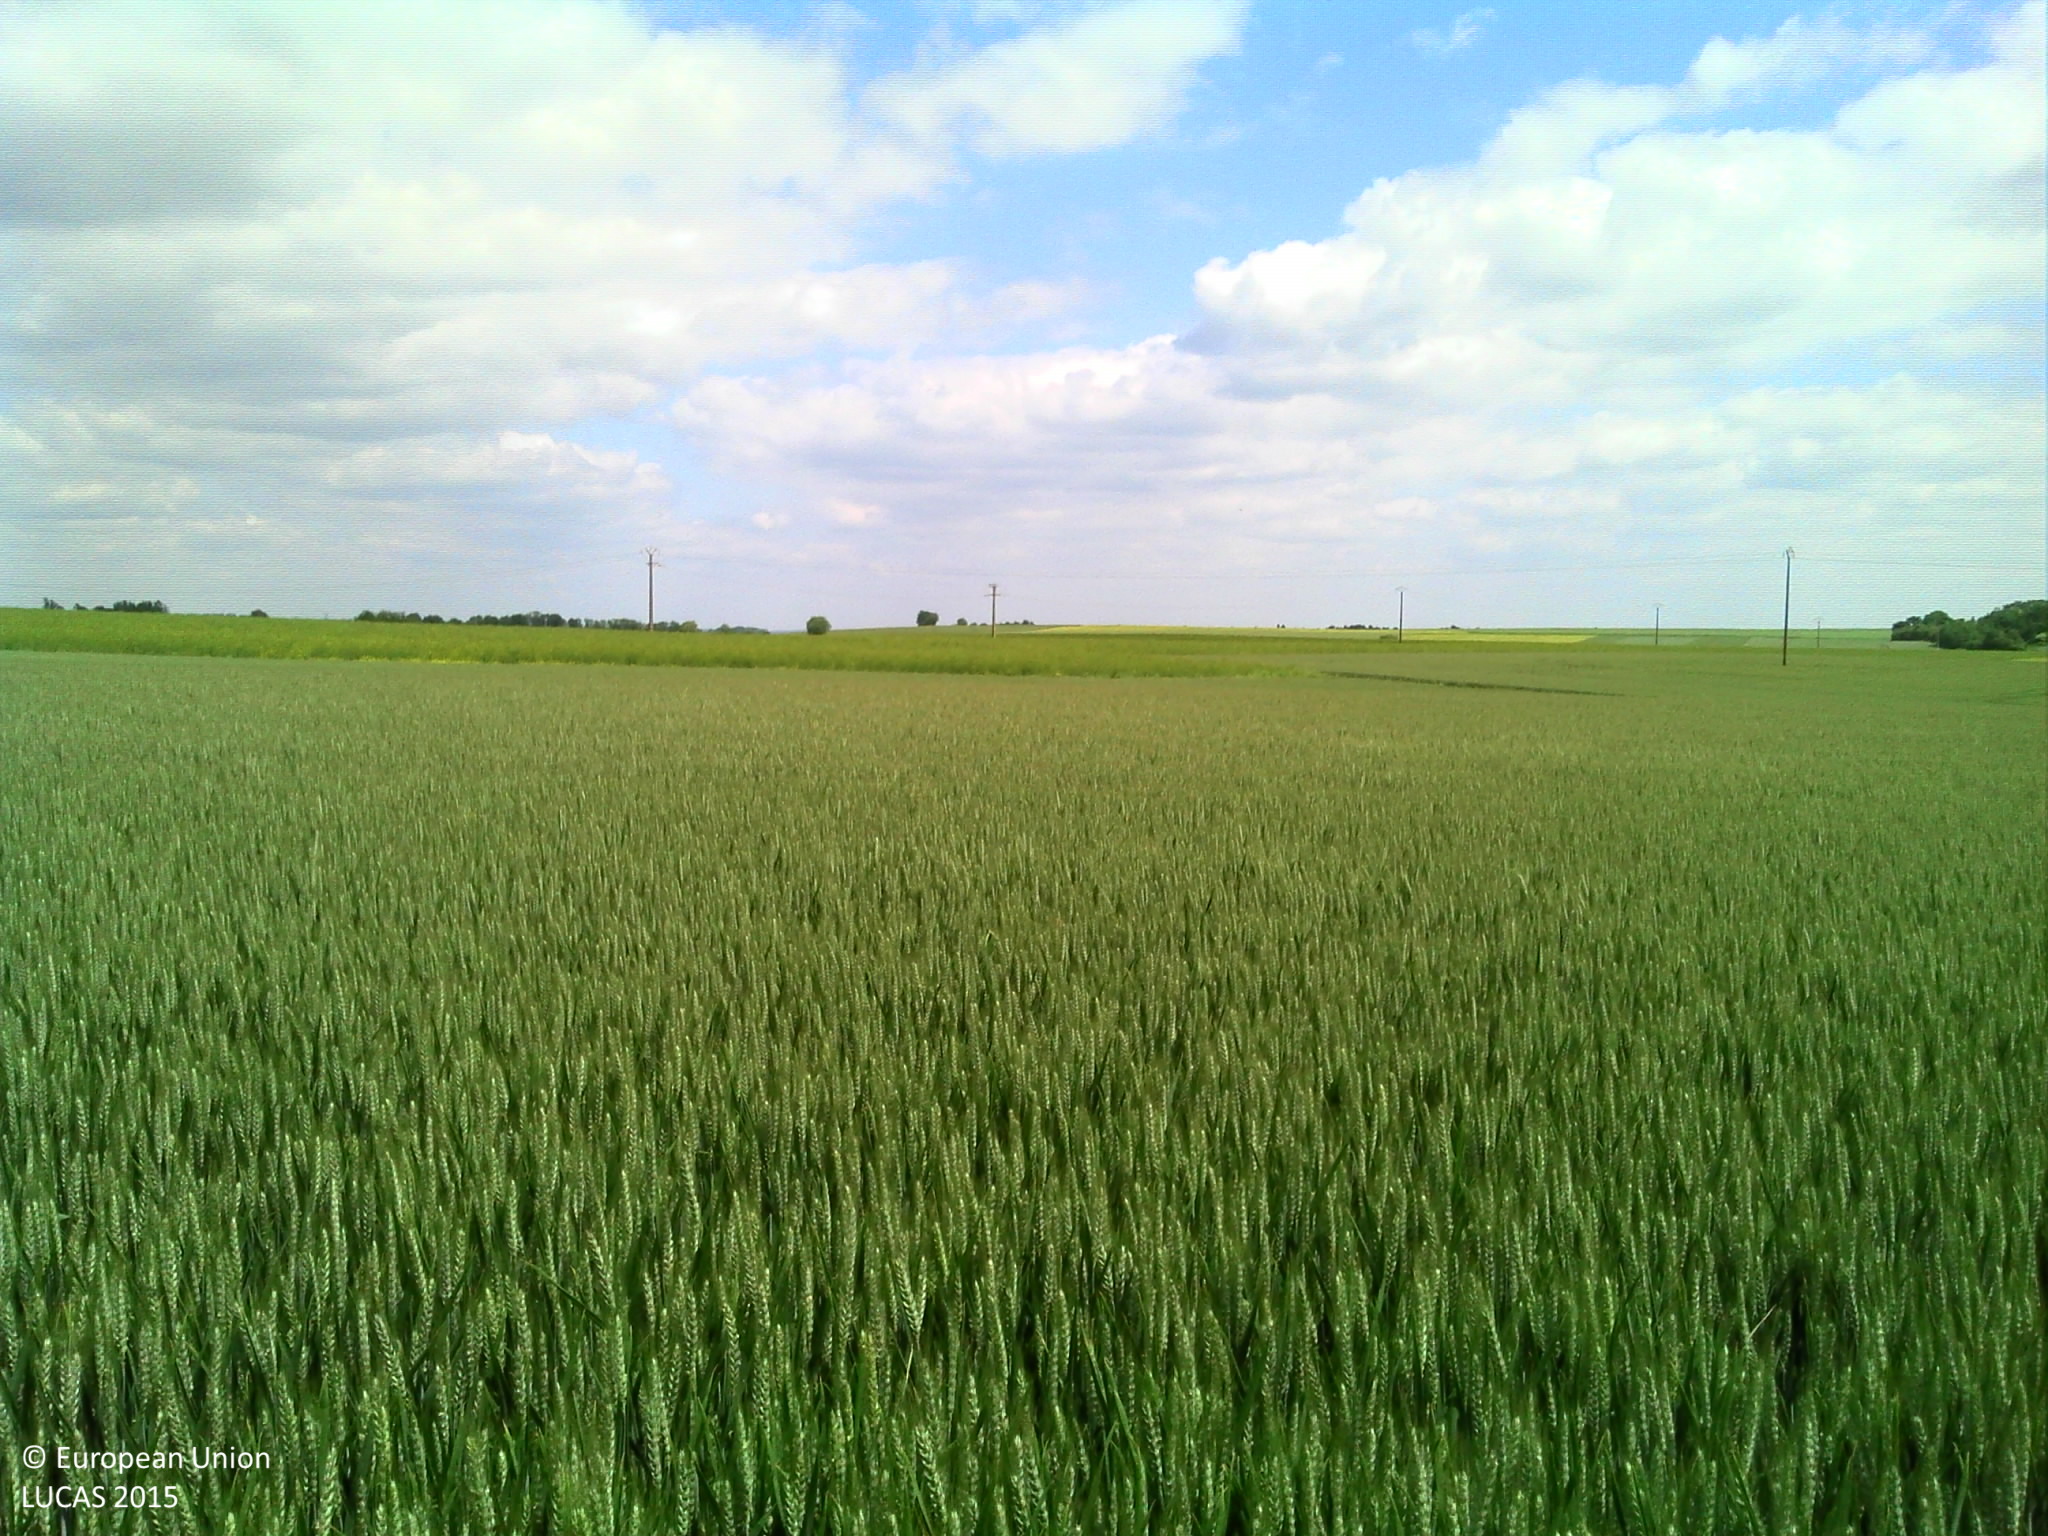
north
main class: Cropland
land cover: Common wheat
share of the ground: > 75 %
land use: Agriculture (excluding fallow land and kitchen gardens)
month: May
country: FR
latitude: 47.4502
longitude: 5.1596
